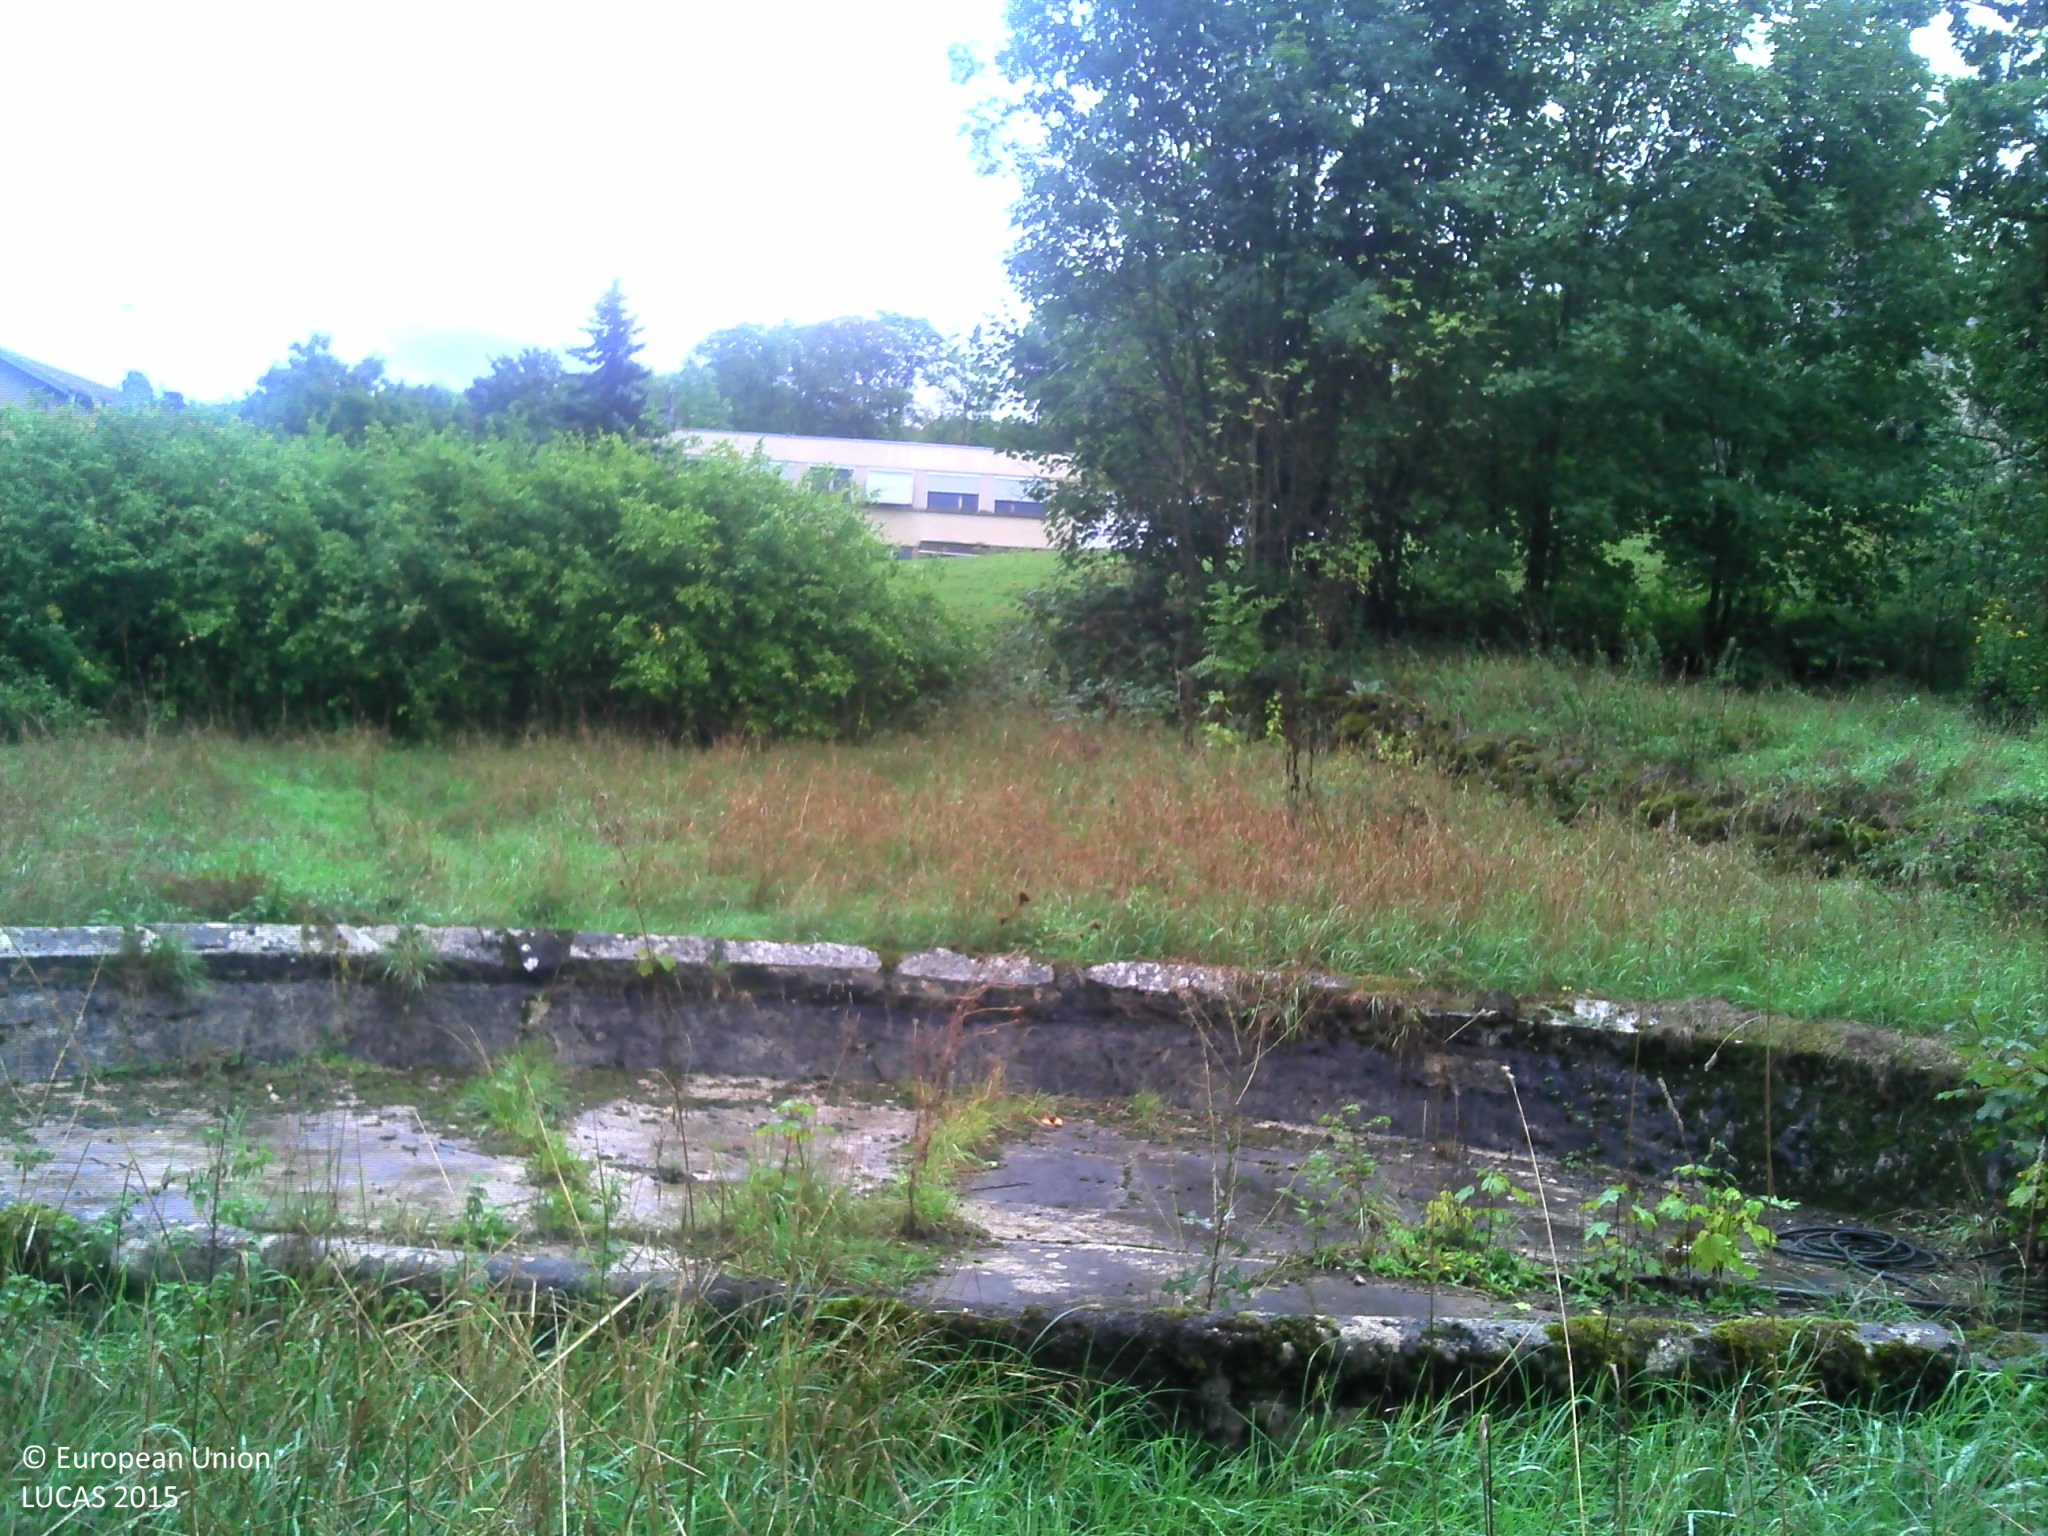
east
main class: Grassland
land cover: Grassland with sparse tree/shrub cover
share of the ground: > 75 %
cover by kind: herbaceous plants 85 %, consolidated bare surface 10 %, broadleaved forest trees 5 %
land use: Community services
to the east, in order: Grassland with sparse tree/shrub cover; Artificial constructions in urban areas; Grassland with sparse tree/shrub cover; Managed hedges; Grass margins; Fences; Grassland without tree/shrub cover; Fences; Grass margins; Paved roads, cycling and walking lanes; Grass margins; Fences; Grassland without tree/shrub cover; Fences; Artificial constructions in urban areas; Broadleaved woodland; Fences; Electric lines; Paved roads, cycling and walking lanes; Grass margins; Ditches and canals; Lines of trees; Grass margins; Paved roads, cycling and walking lanes; Grass margins; Shrubland with sparse tree cover; Grass margins; Paved roads, cycling and walking lanes; Grass margins; Ditches and canals; Broadleaved woodland
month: September
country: FR
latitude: 48.7338
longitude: 6.1794
